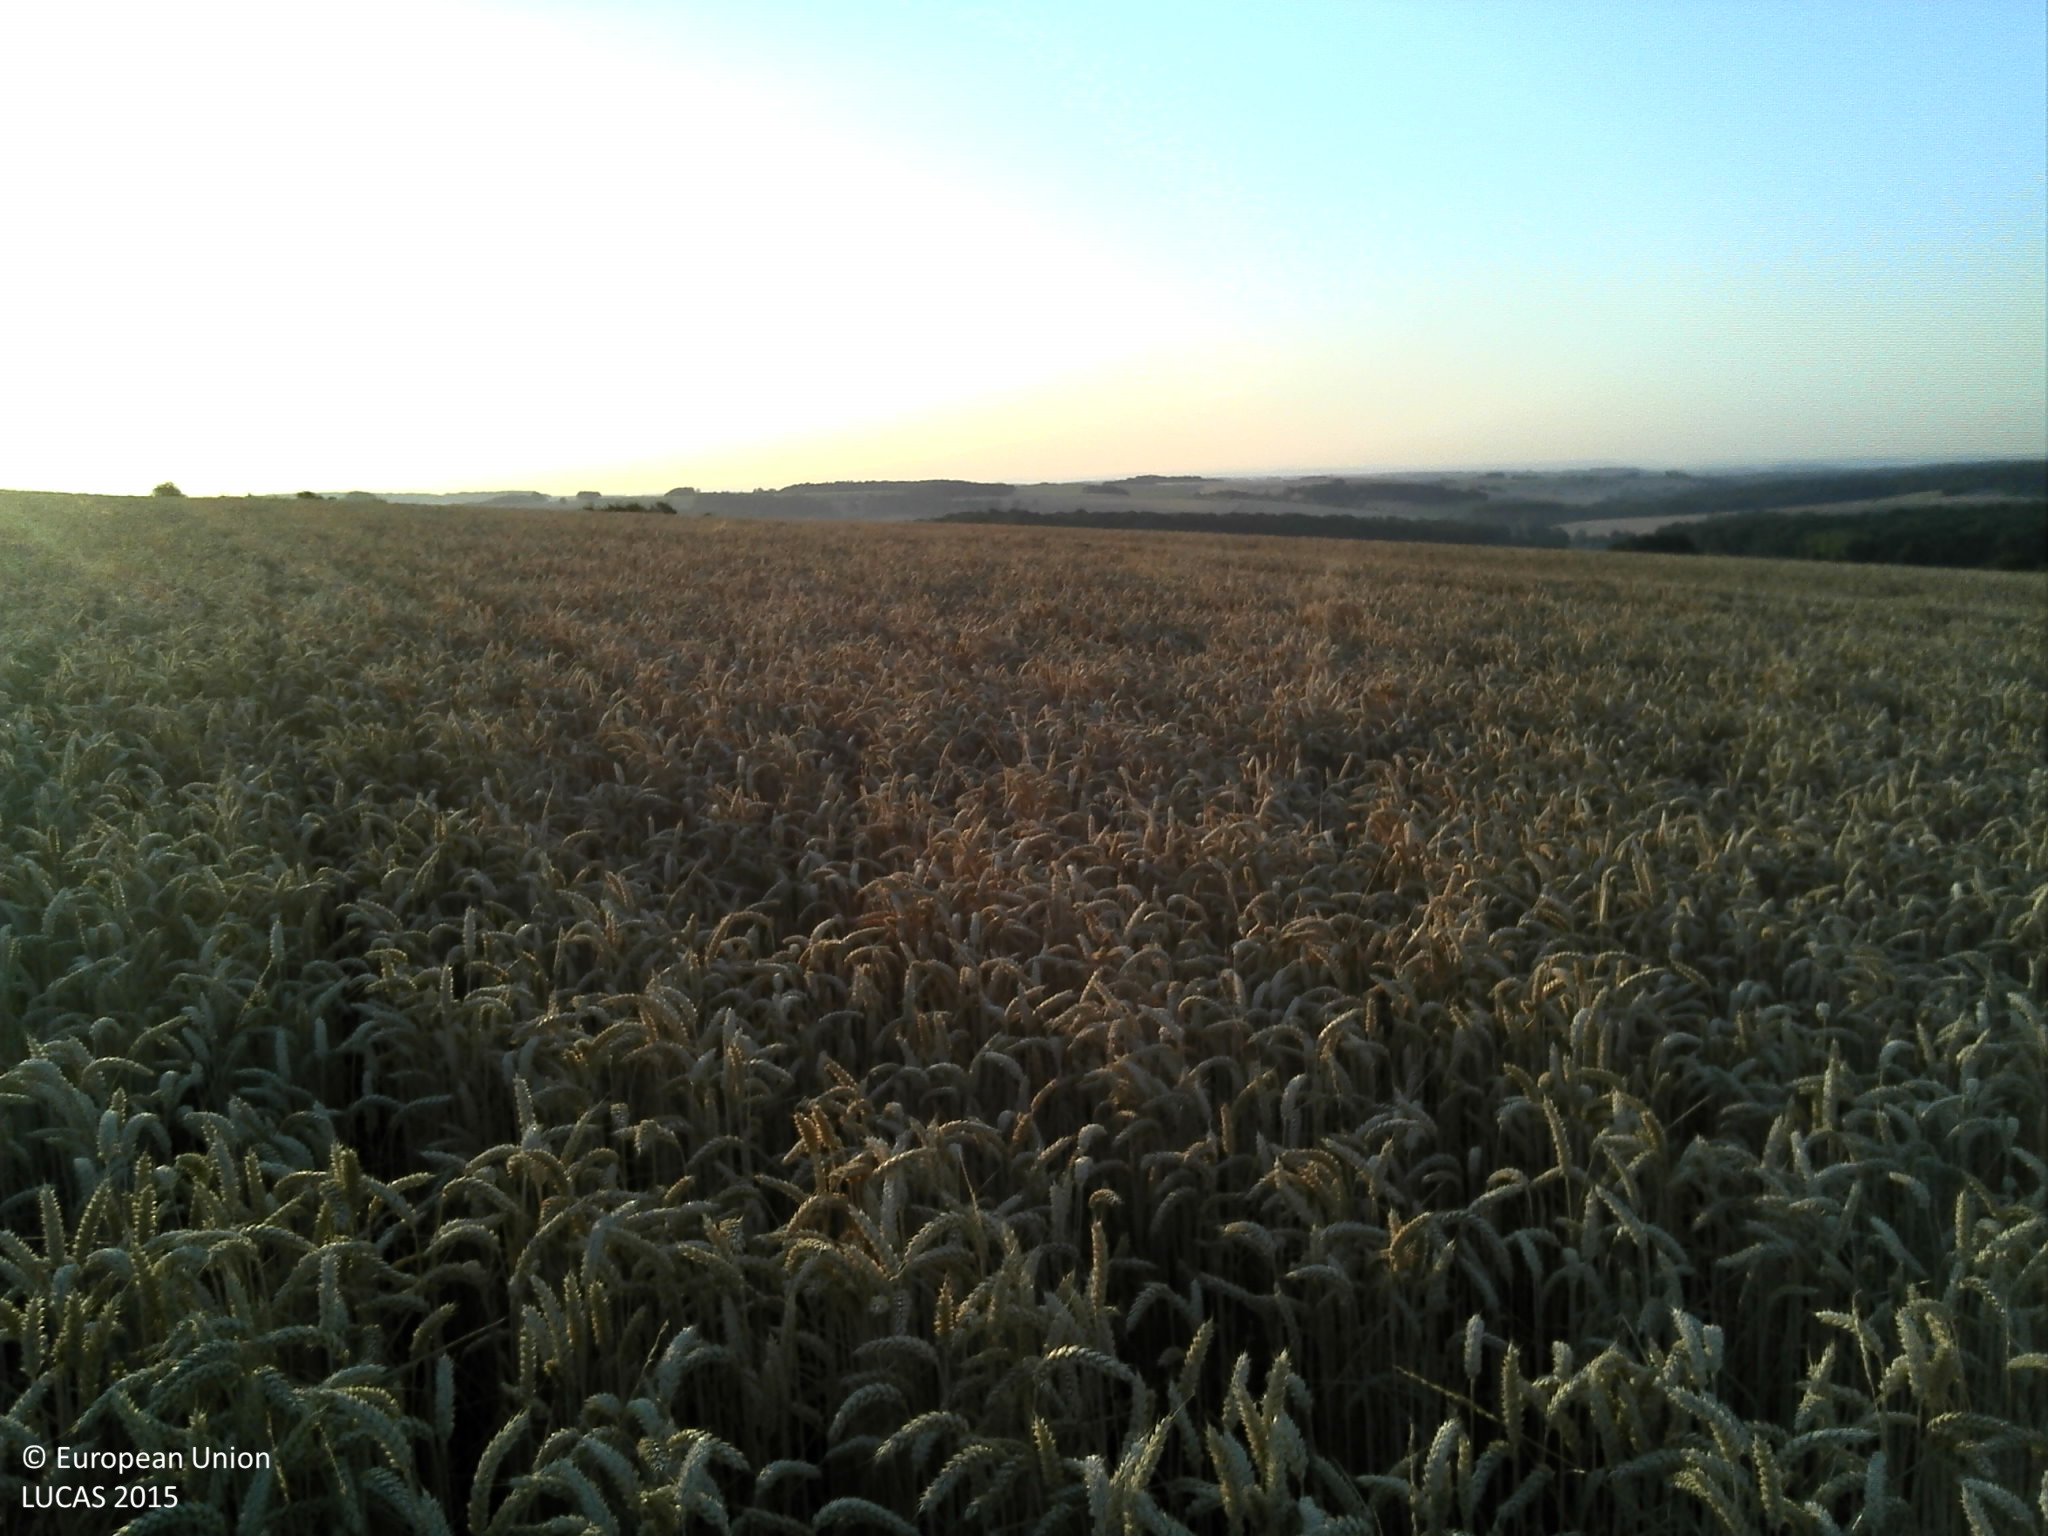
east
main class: Cropland
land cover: Common wheat
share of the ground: > 75 %
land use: Agriculture (excluding fallow land and kitchen gardens)
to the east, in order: Common wheat
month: July
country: FR
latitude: 48.1911
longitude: 6.1128
